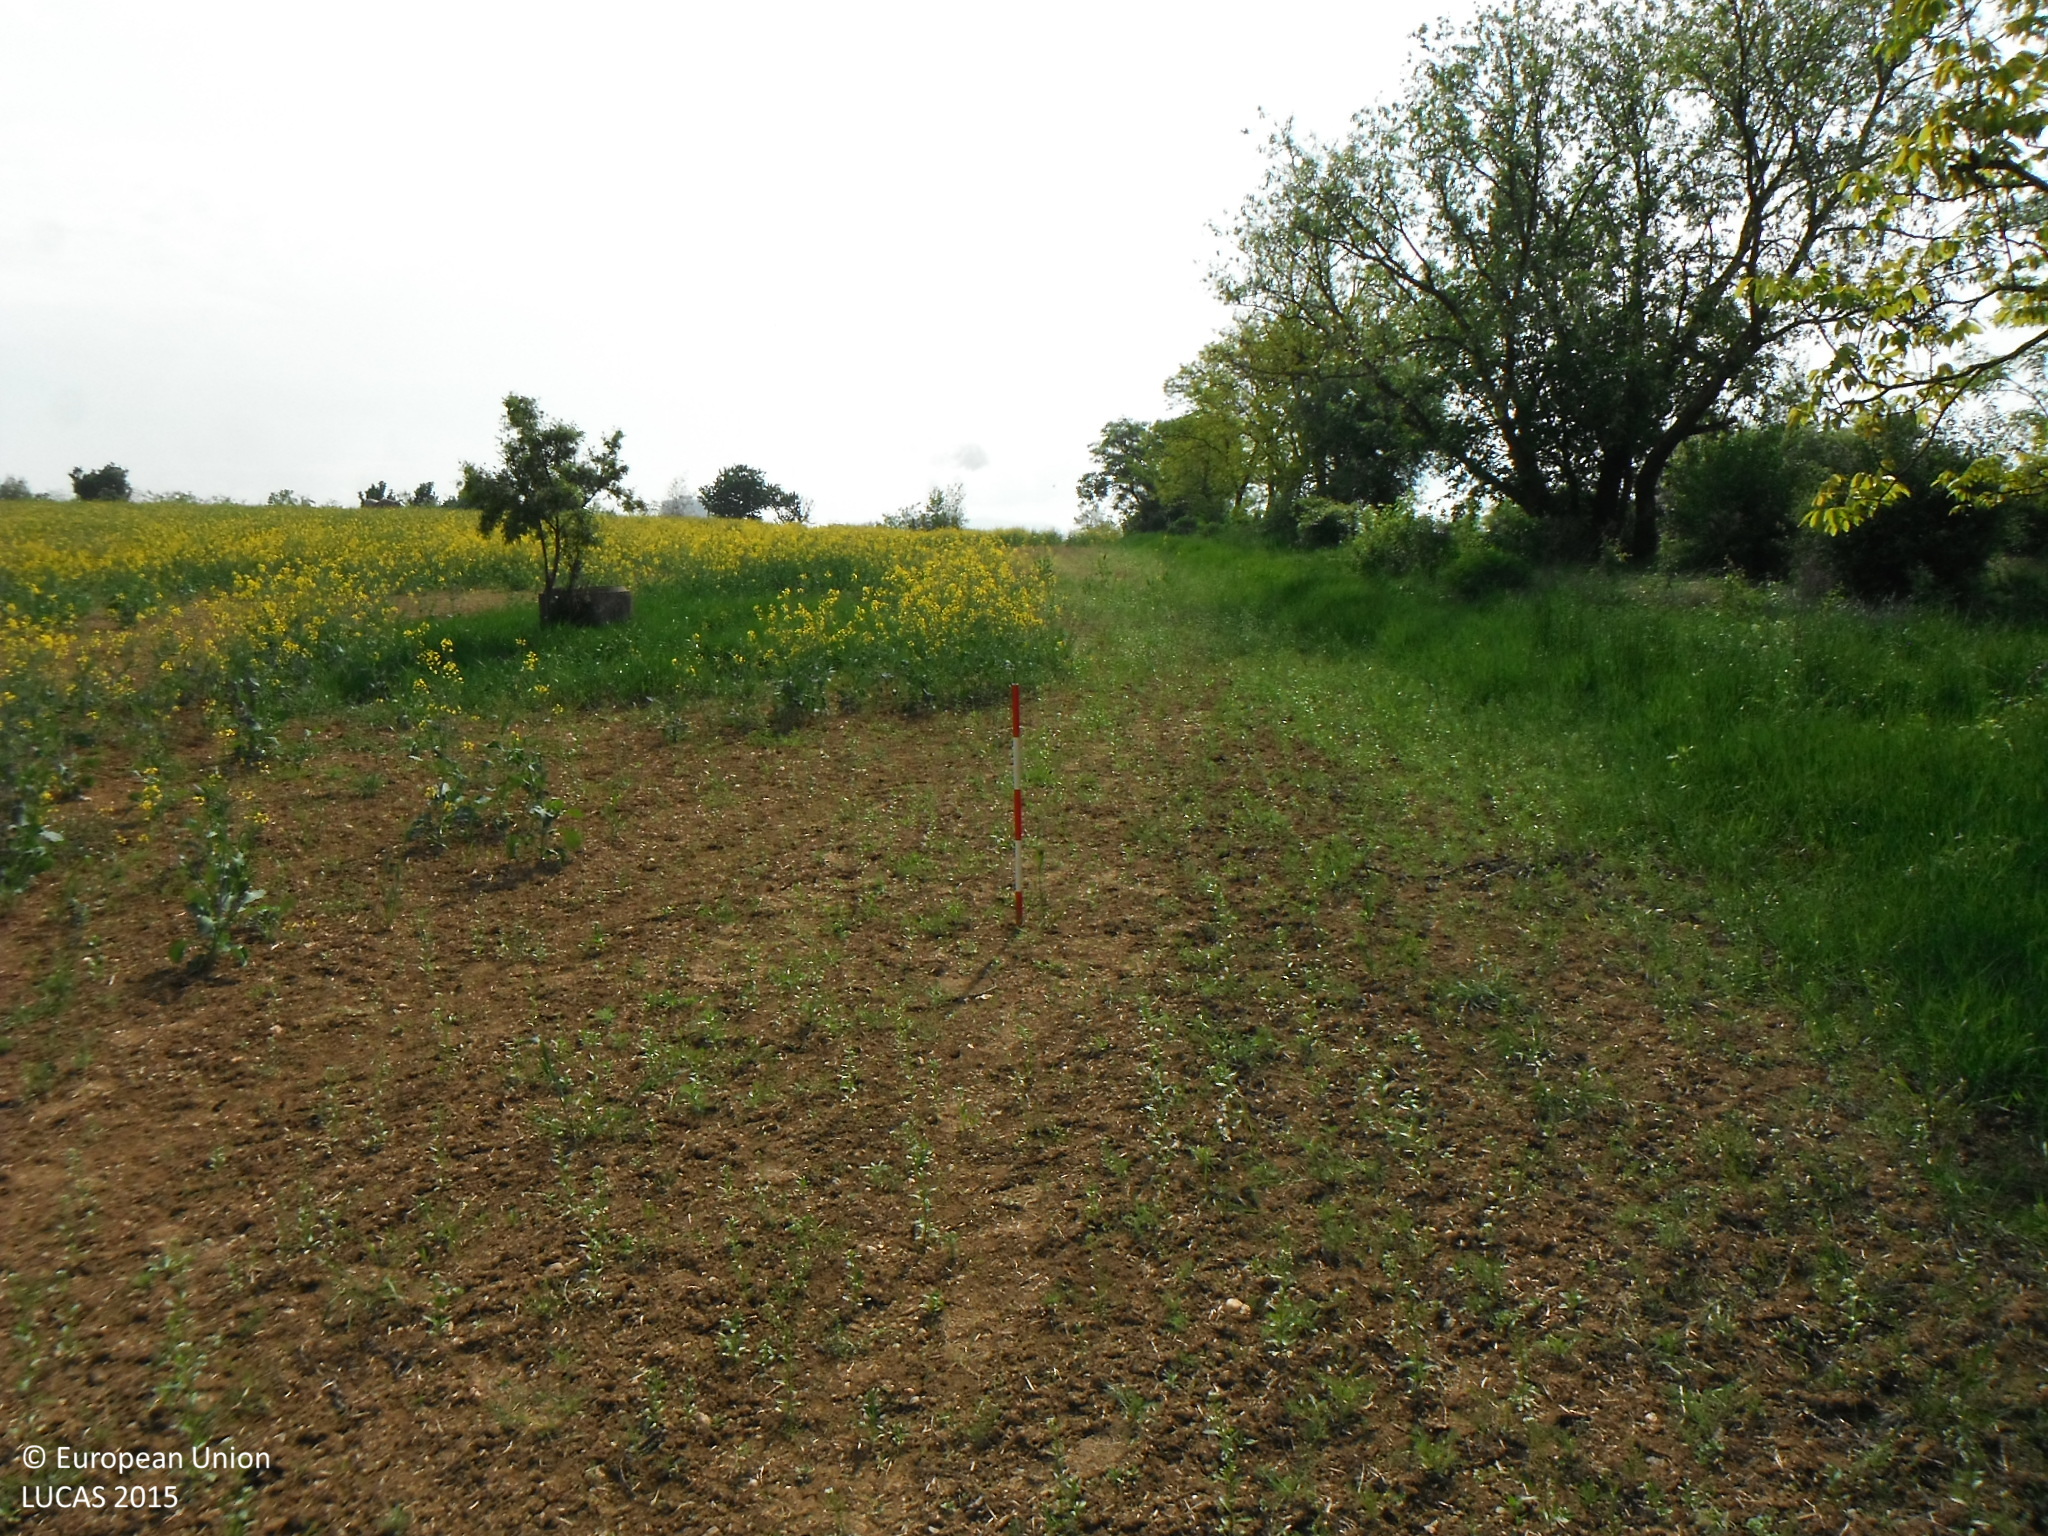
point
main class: Cropland
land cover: Rape and turnip rape
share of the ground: < 10 %
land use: Agriculture (excluding fallow land and kitchen gardens)
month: May
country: SK
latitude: 48.6005
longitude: 21.1489
